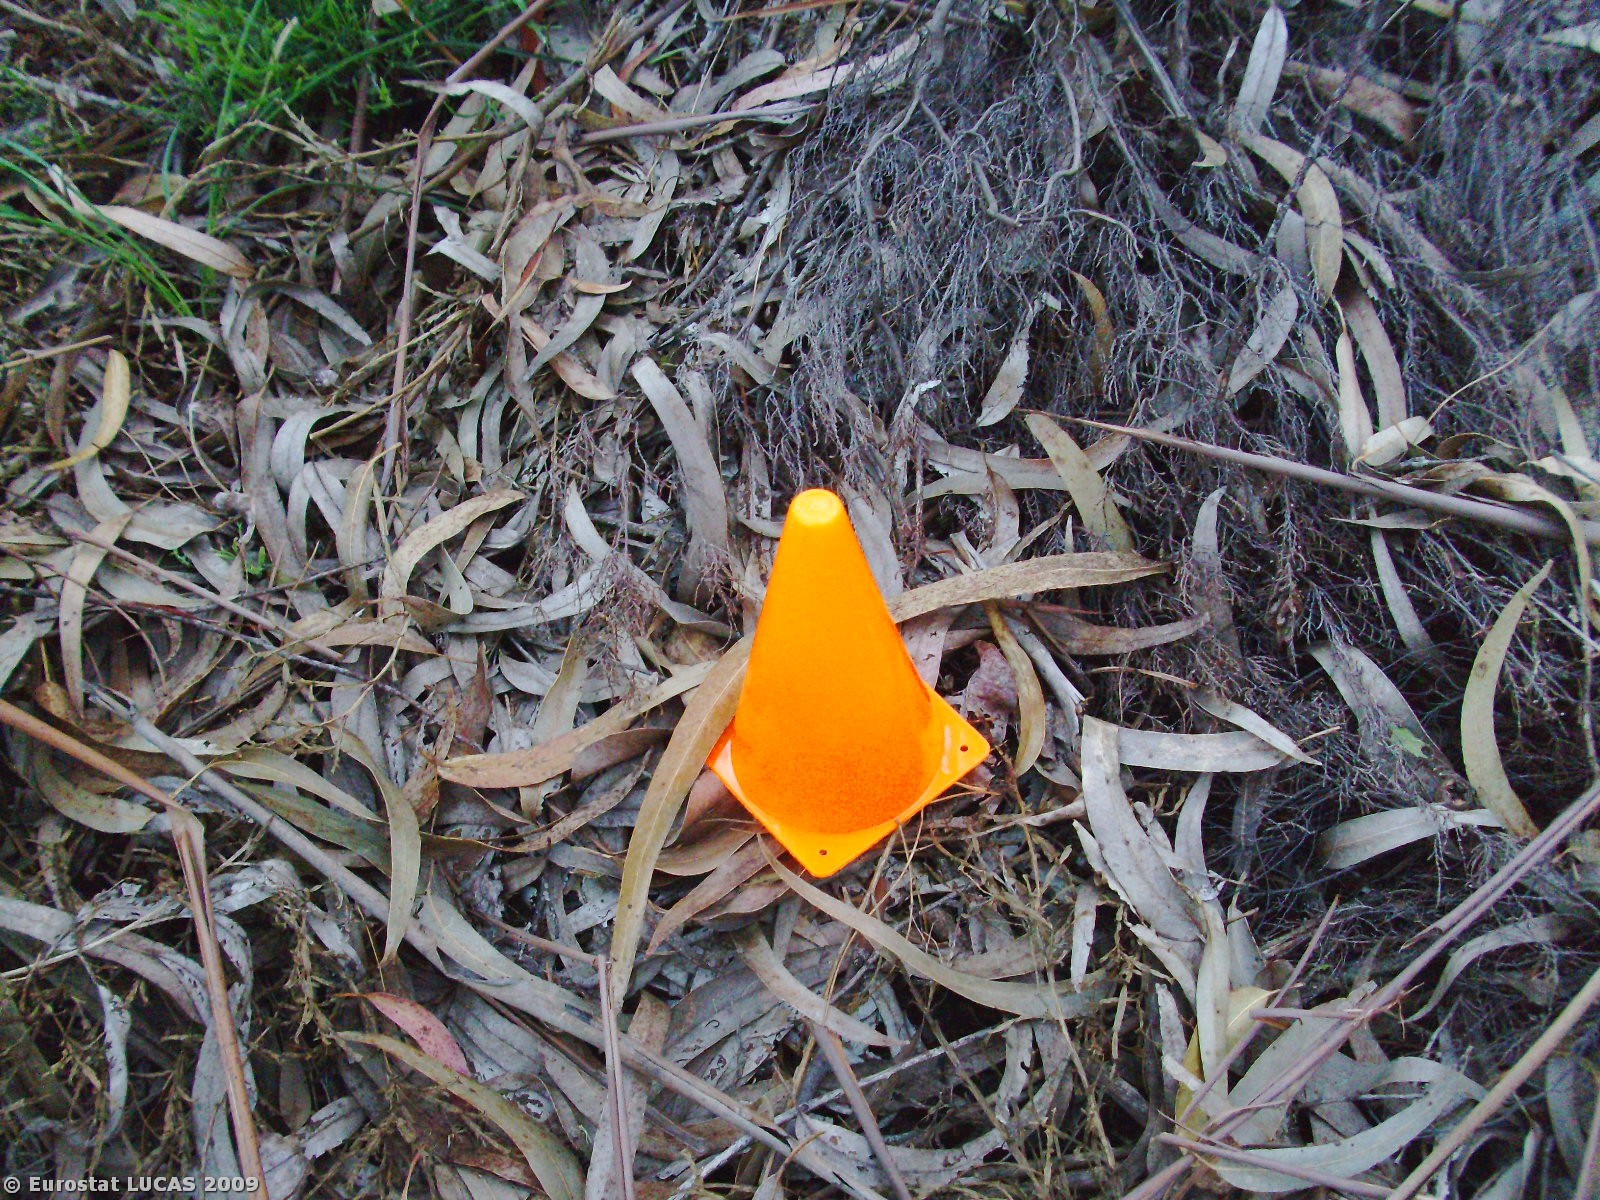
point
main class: Woodland
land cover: Broadleaved woodland
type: plantations and self-sown exotic forest
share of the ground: > 75 %
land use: Forestry
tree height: > 5 m
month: May
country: PT
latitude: 40.7757
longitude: -8.4471
